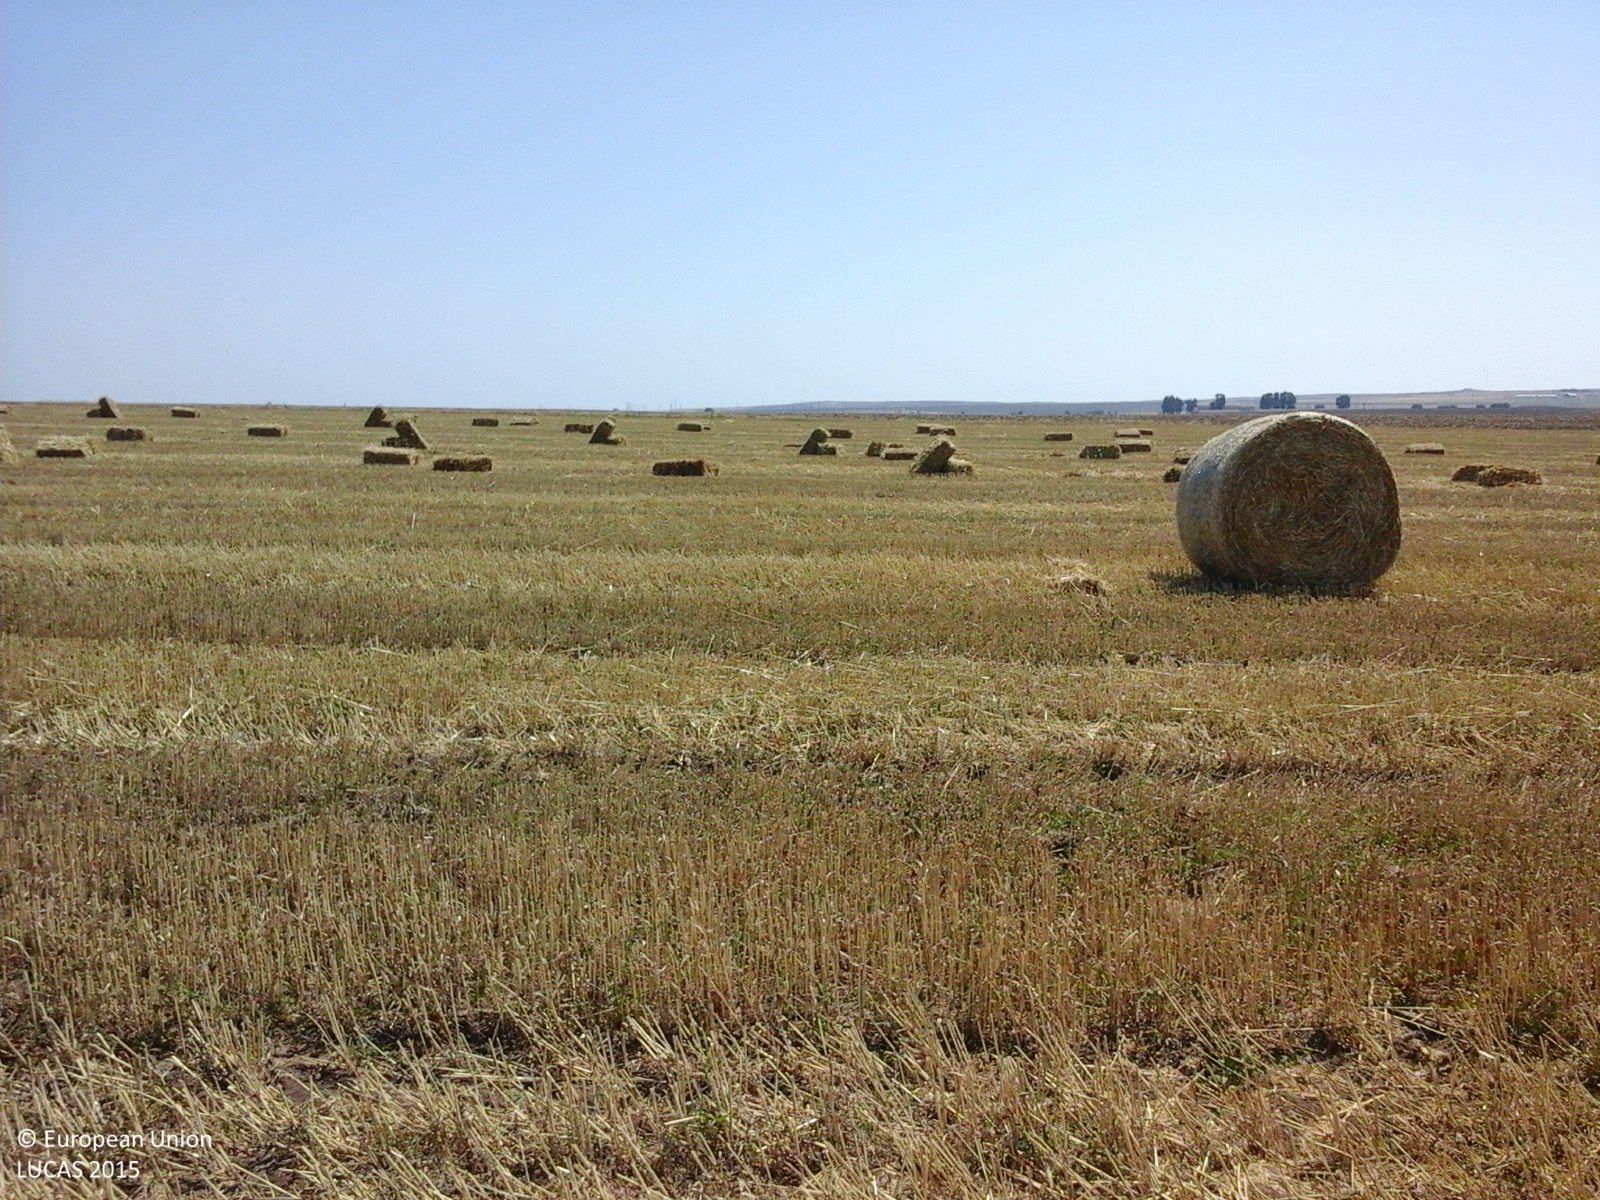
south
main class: Cropland
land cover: Common wheat
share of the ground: > 75 %
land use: Agriculture (excluding fallow land and kitchen gardens)
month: August
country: RO
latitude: 44.6669
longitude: 28.6852
